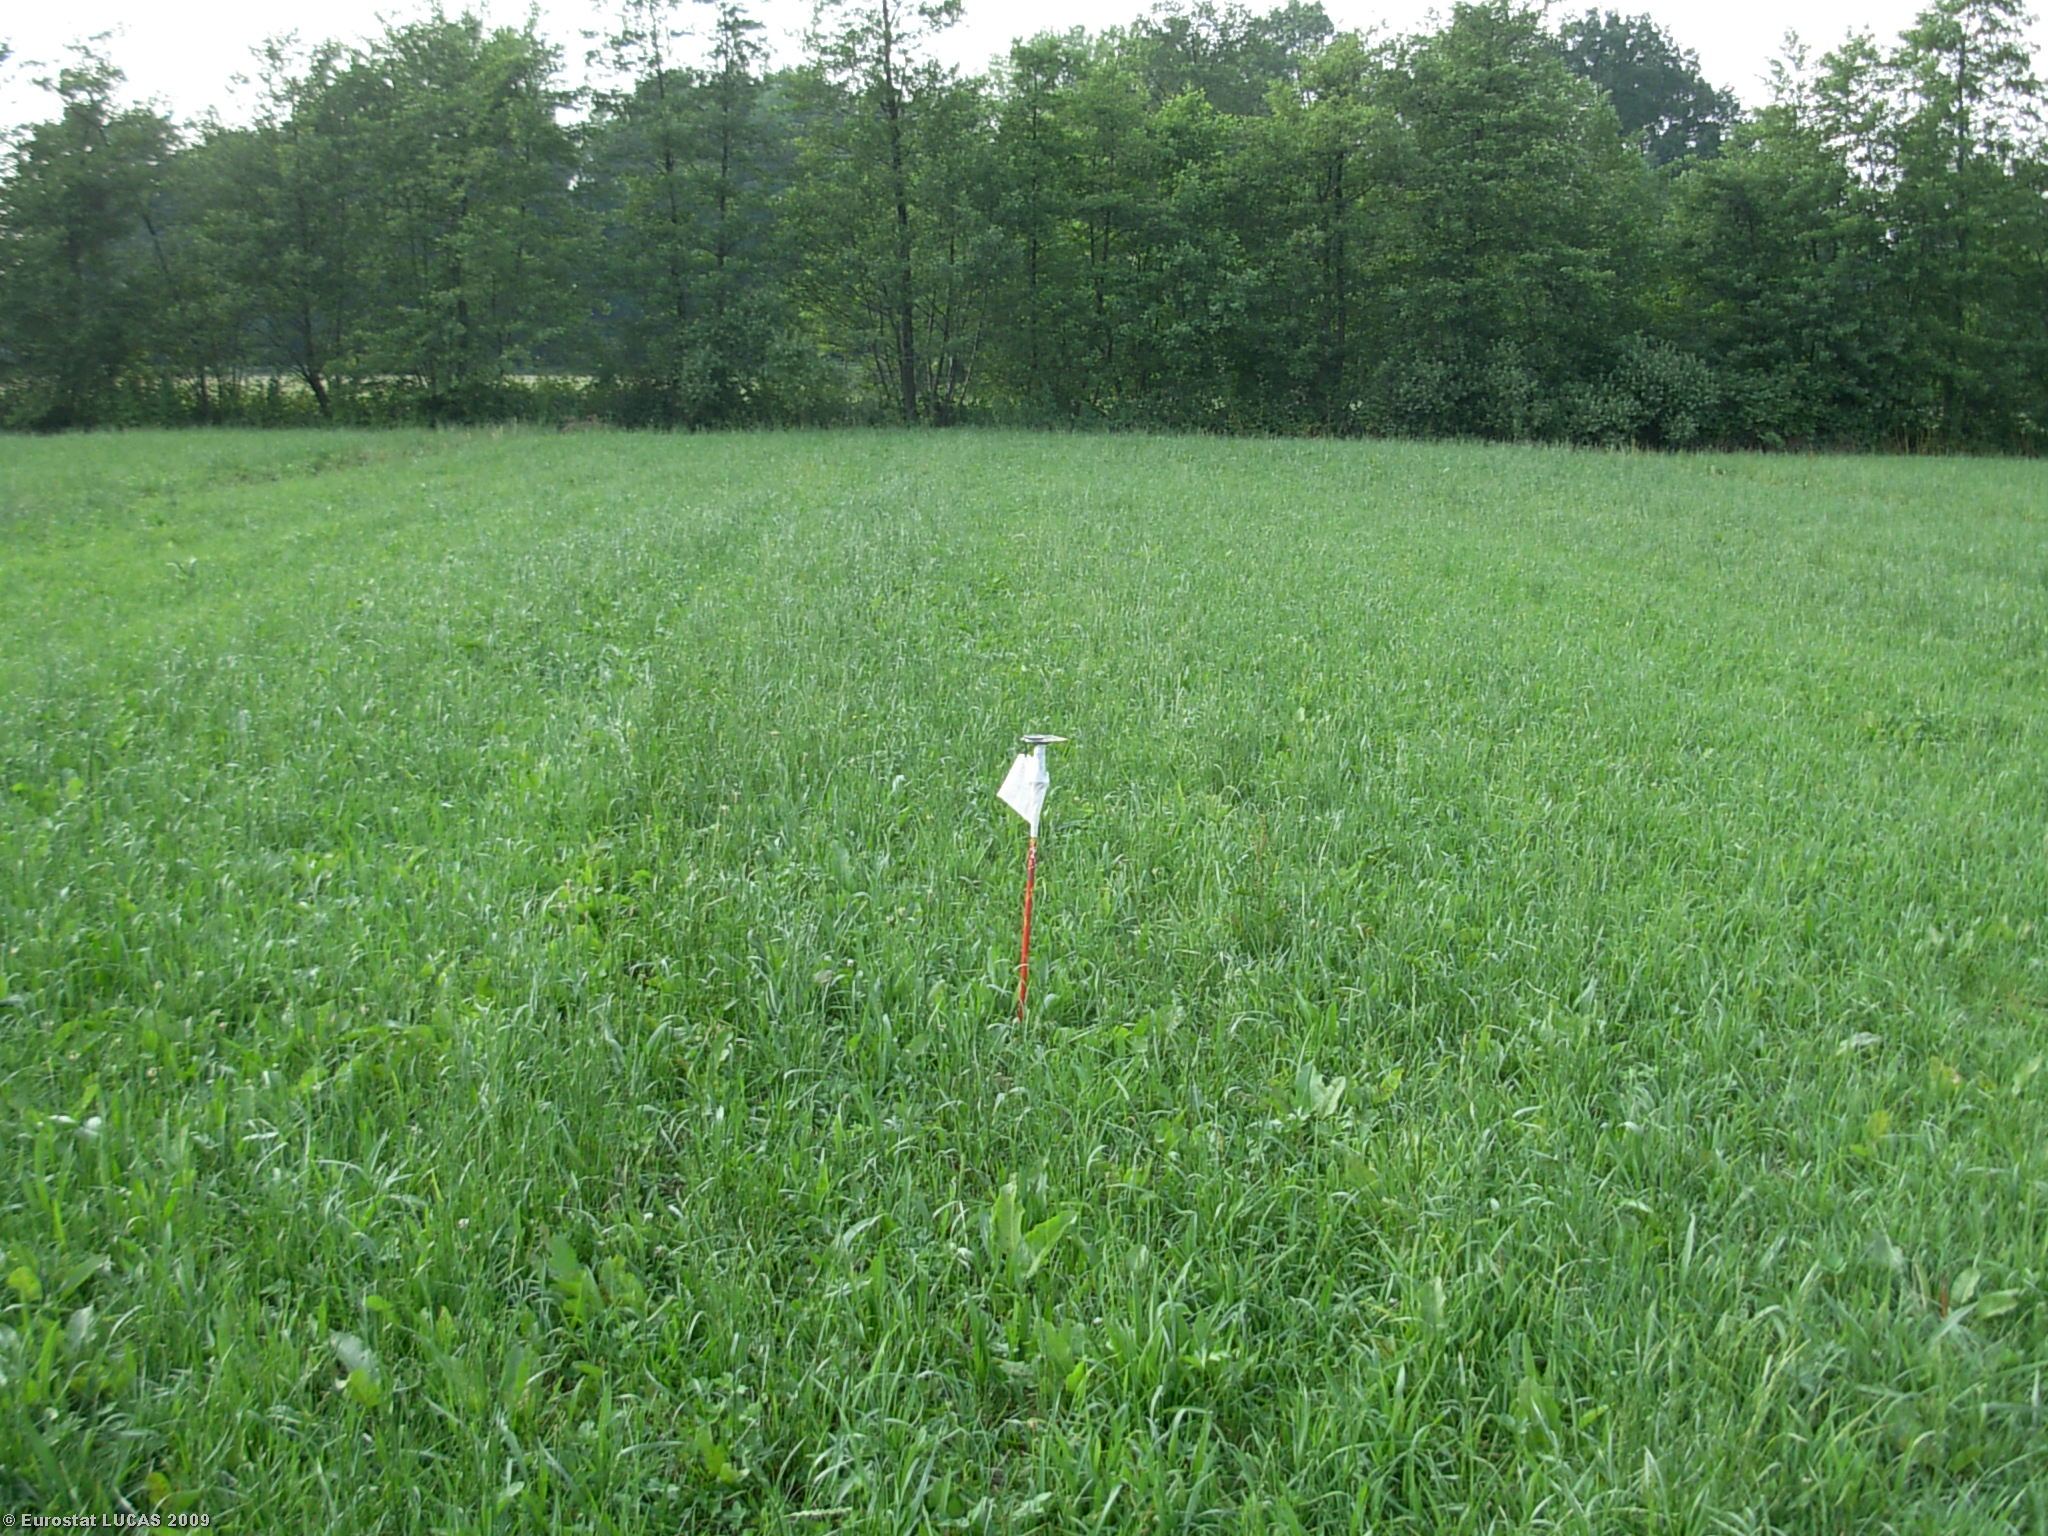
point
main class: Grassland
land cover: Grassland without tree/shrub cover
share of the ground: > 75 %
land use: Agriculture (excluding fallow land and kitchen gardens)
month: June
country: IT
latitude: 45.7183
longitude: 9.2945
